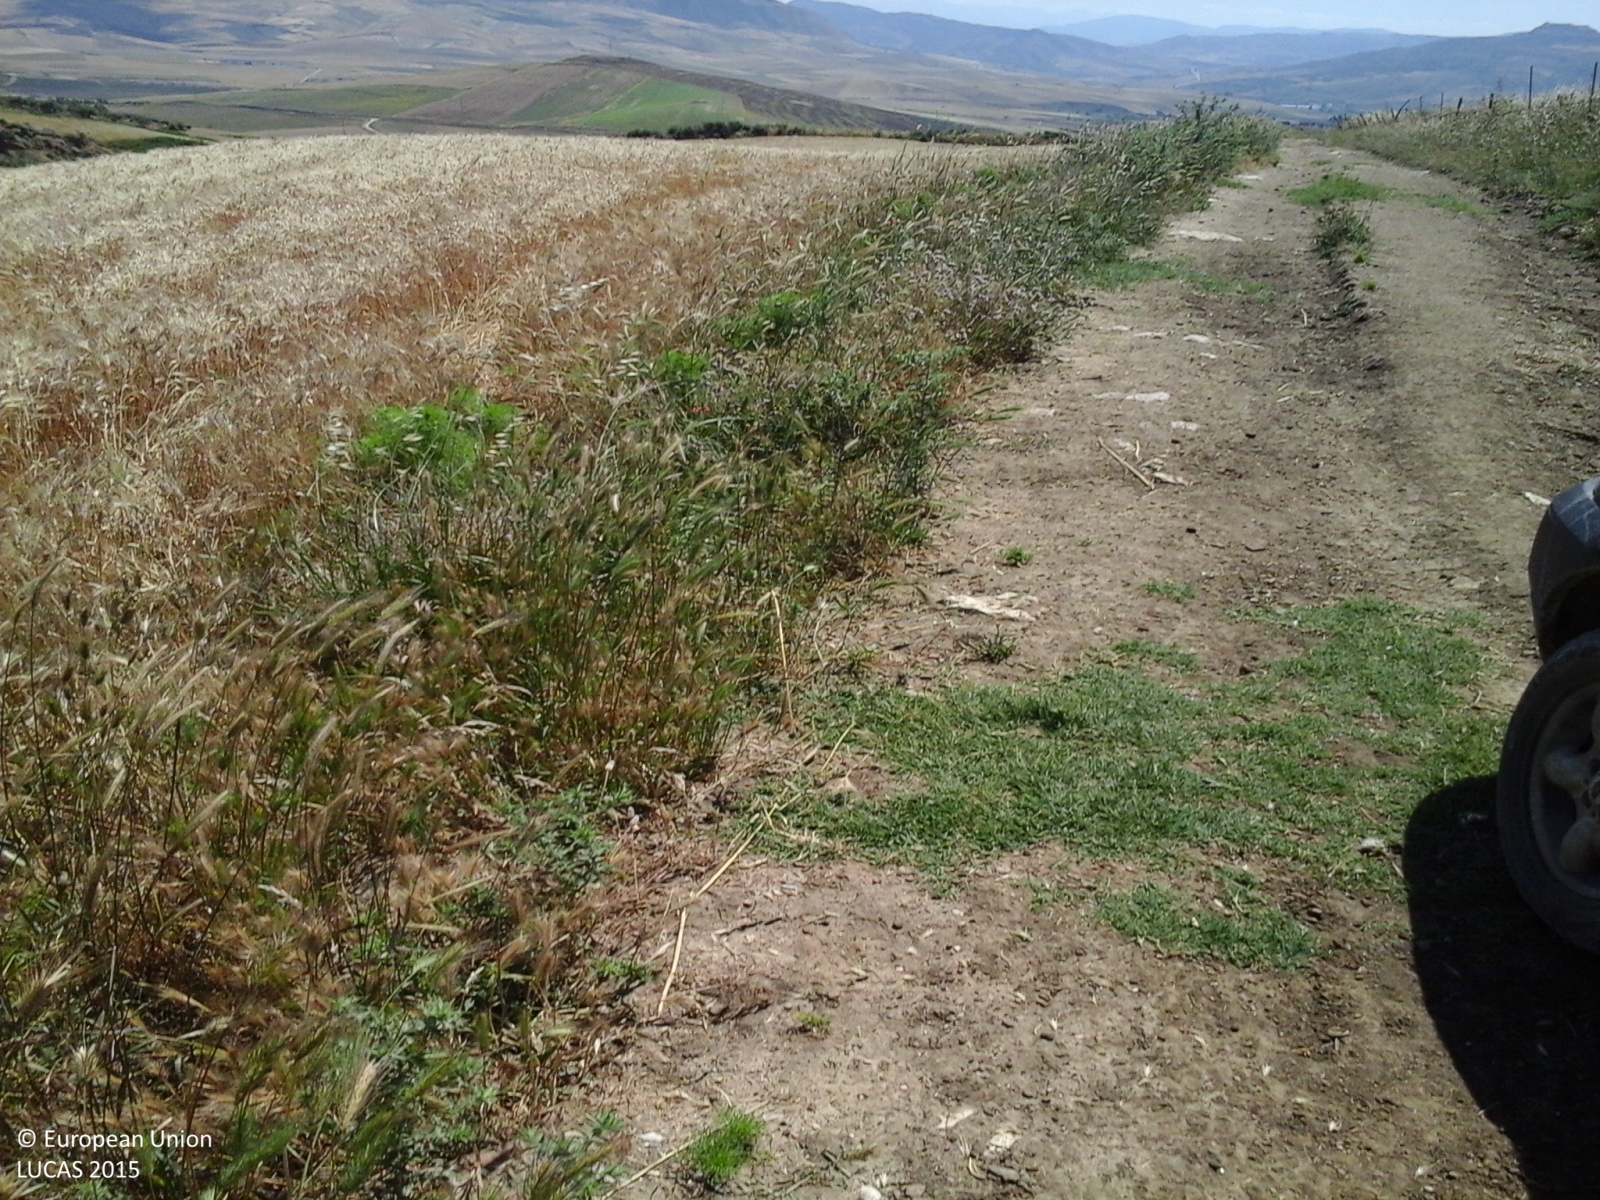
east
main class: Cropland
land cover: Durum wheat
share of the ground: > 75 %
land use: Agriculture (excluding fallow land and kitchen gardens)
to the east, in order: Durum wheat; Abandoned hedges; Durum wheat
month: June
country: IT
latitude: 37.8471
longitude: 13.4863
